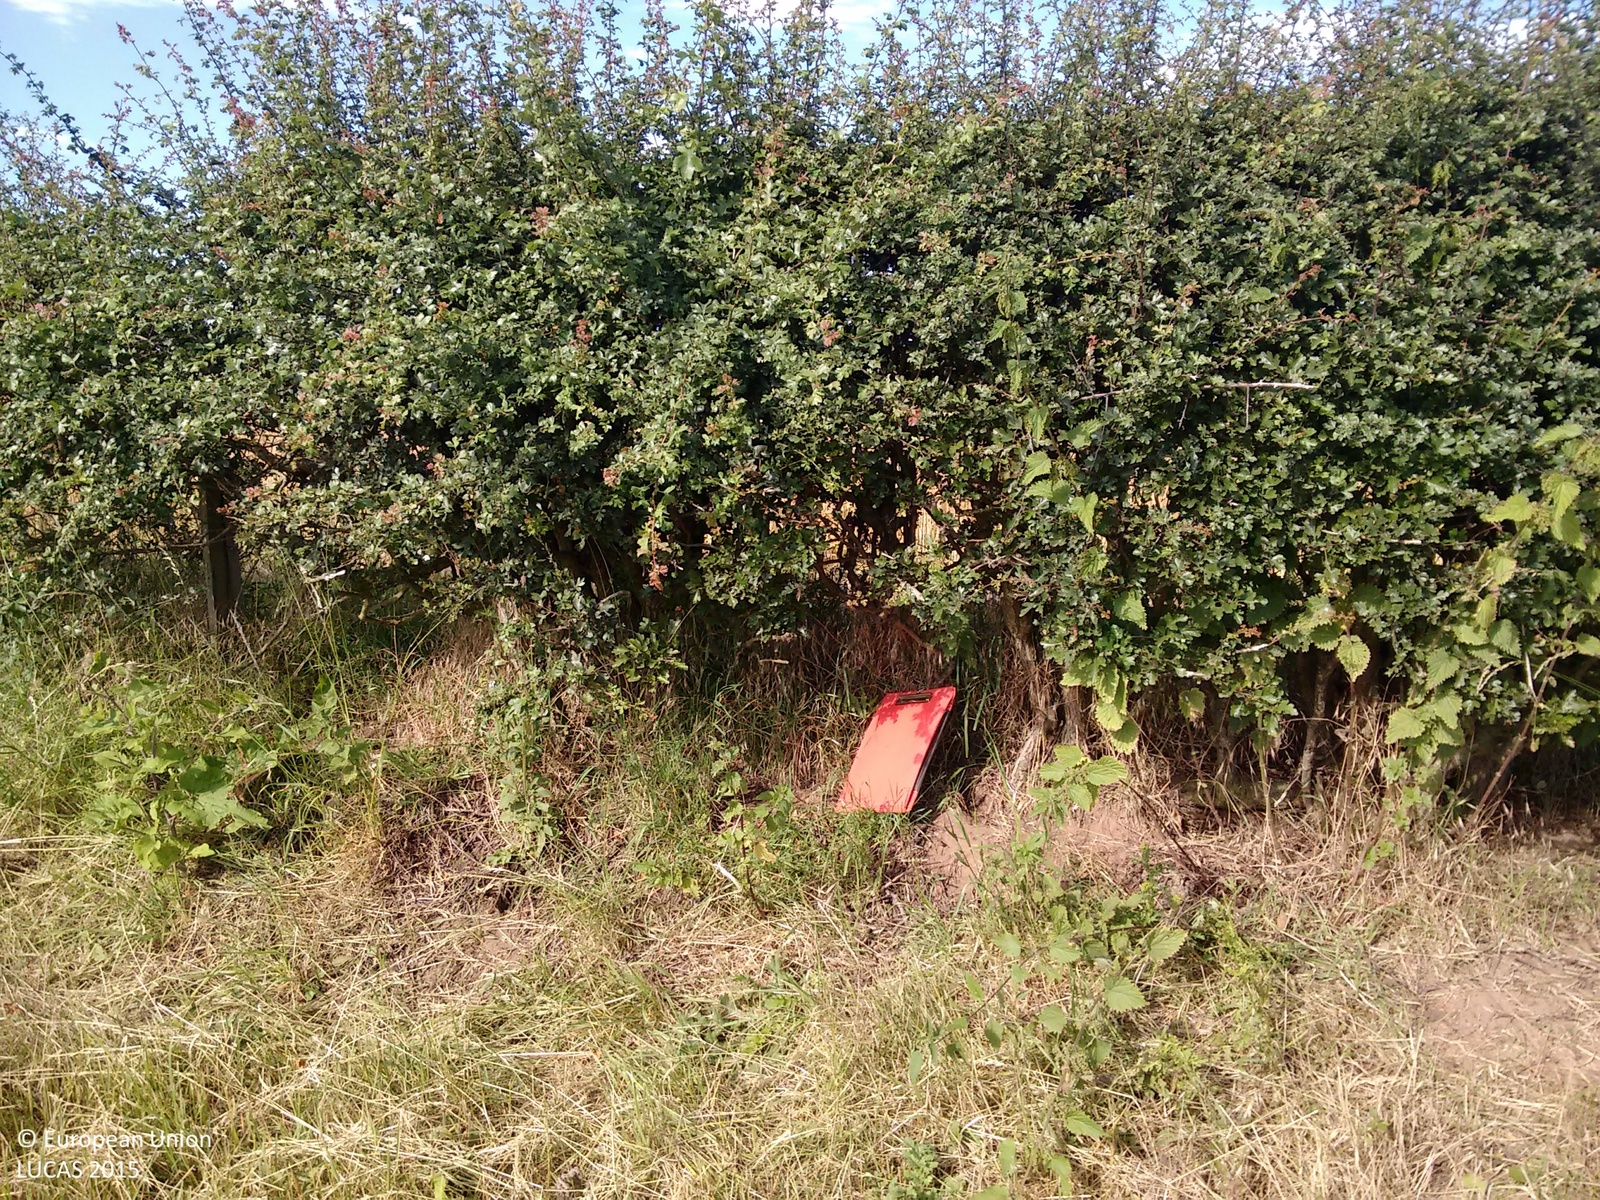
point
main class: Cropland
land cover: Barley
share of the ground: > 75 %
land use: Agriculture (excluding fallow land and kitchen gardens)
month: July
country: GB
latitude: 53.2824
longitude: -0.9774
